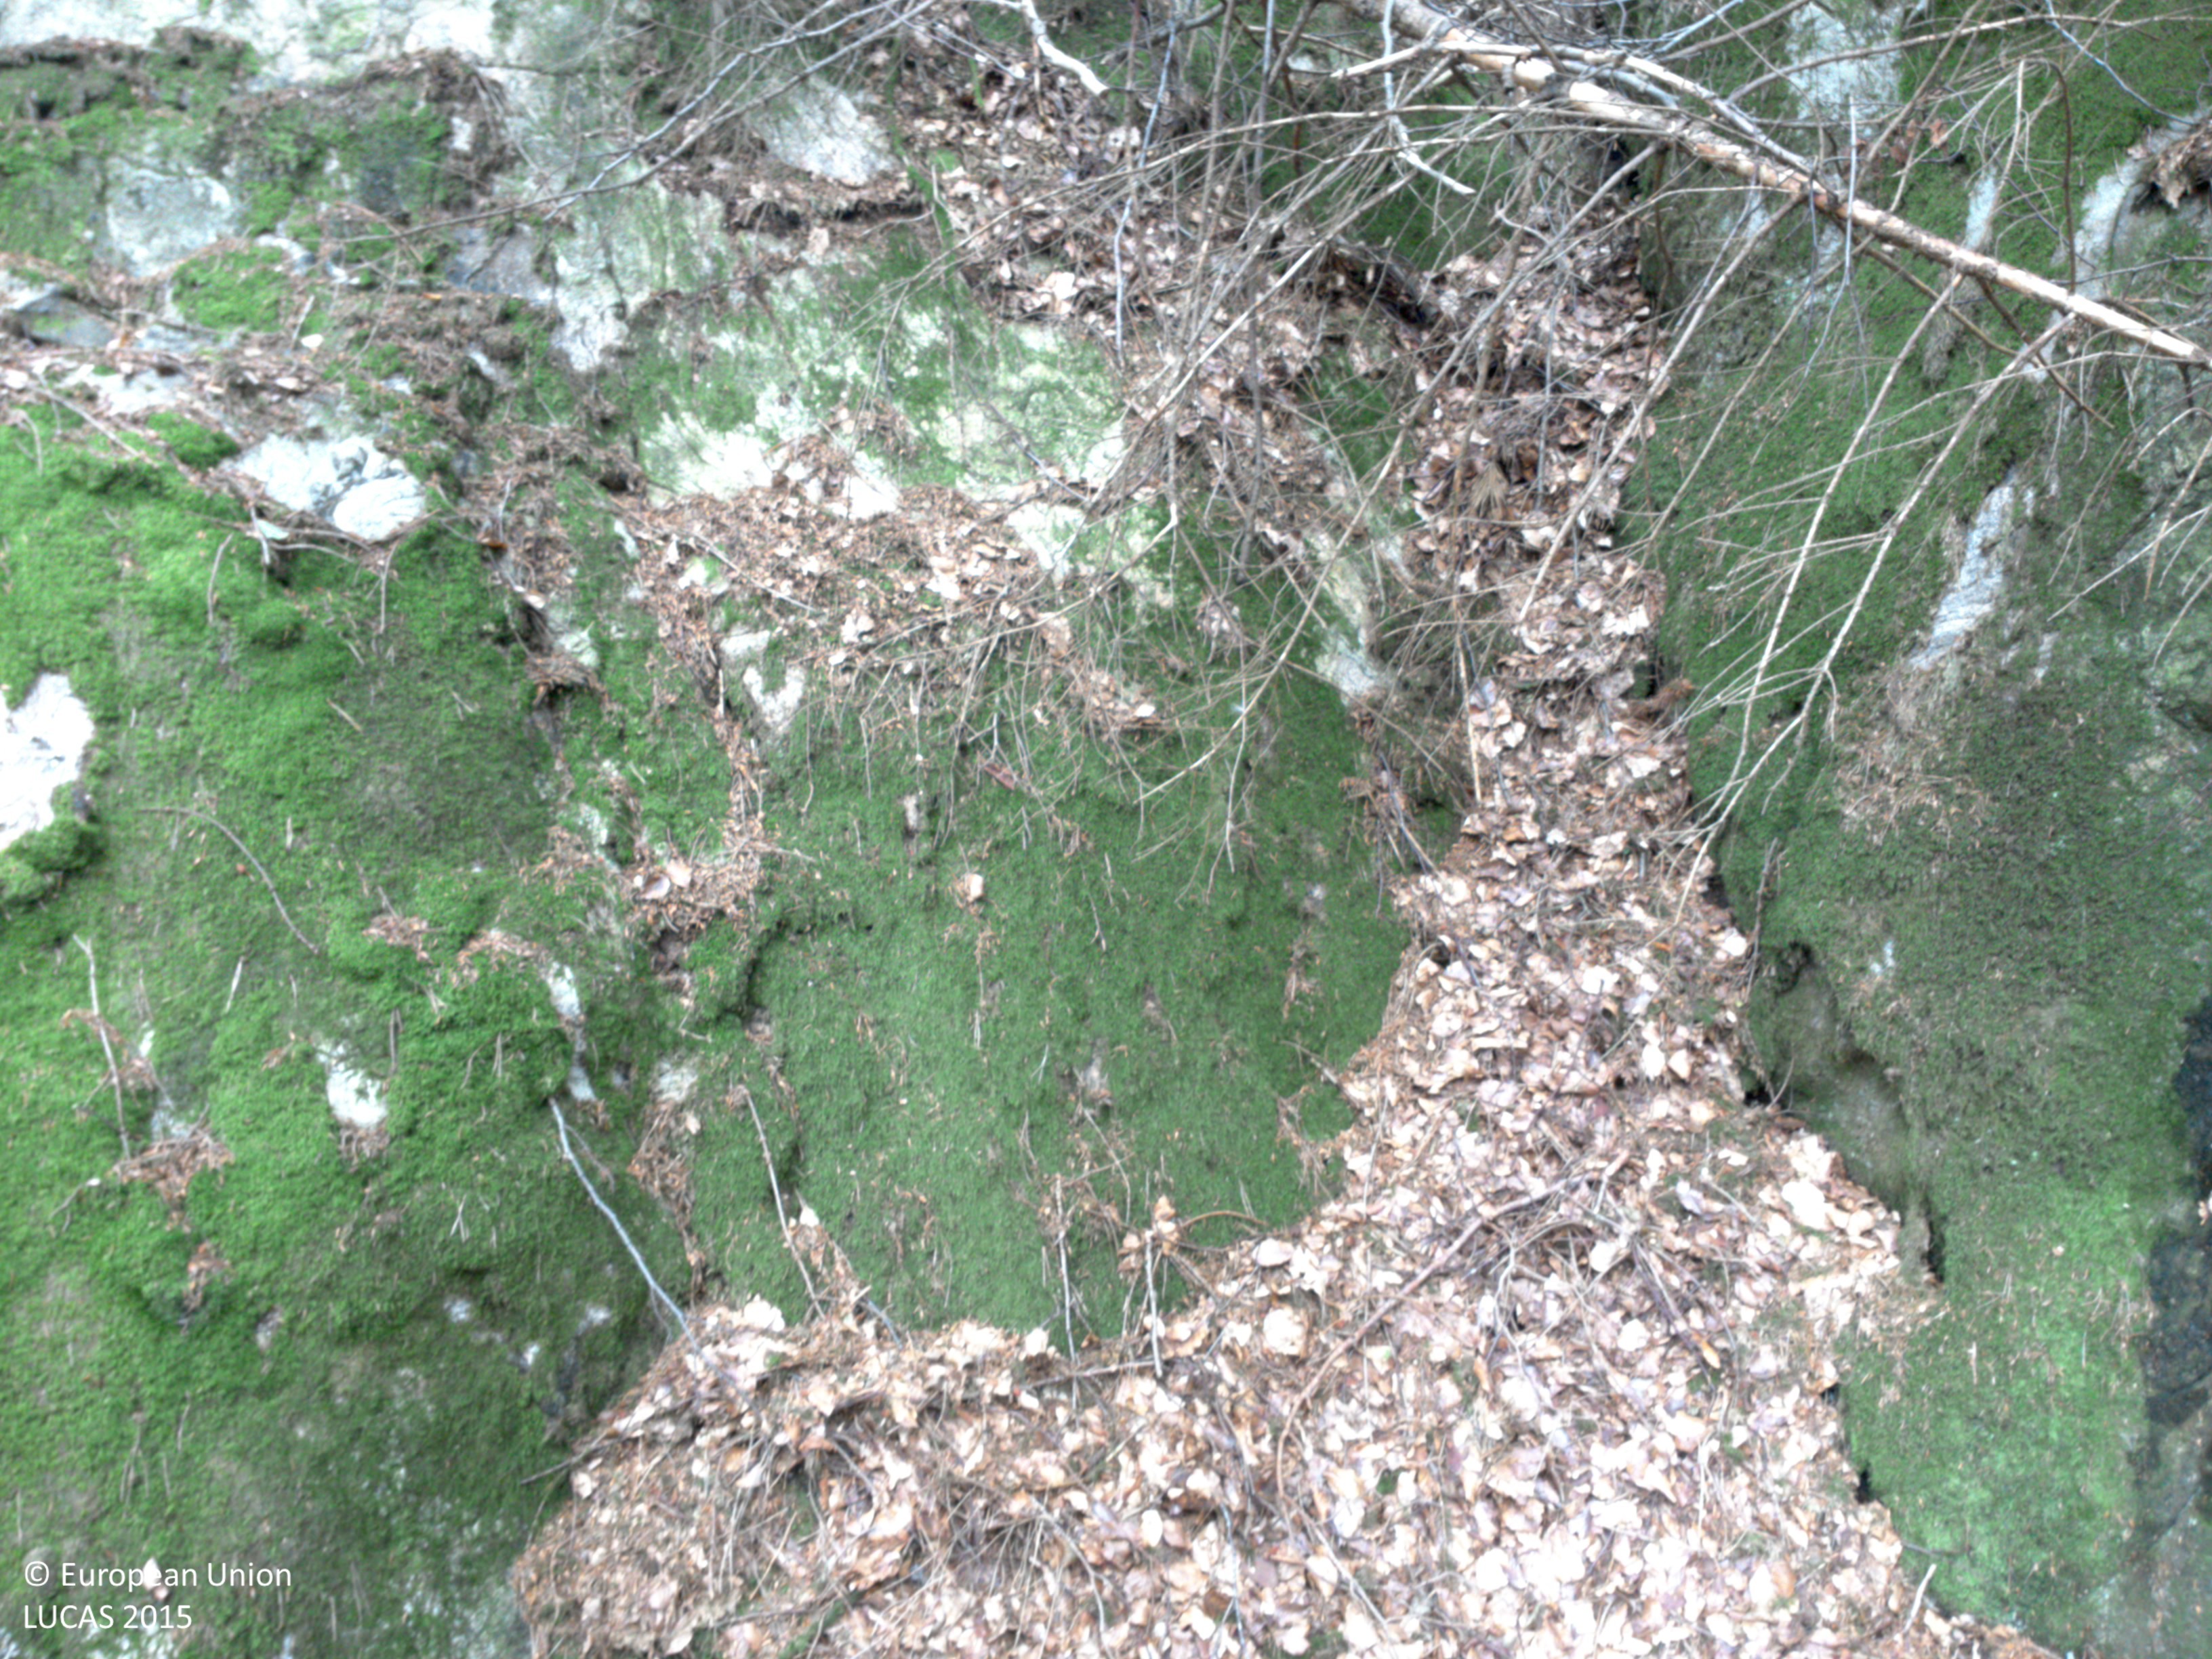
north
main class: Woodland
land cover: Spruce dominated mixed woodland
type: boreal forest
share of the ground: 50 - 75 %
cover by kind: unconsolidated bare surface 40 %, broadleaved forest trees 35 %, coniferous forest trees 20 %, shrubs 5 %
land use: Forestry
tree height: > 5 m
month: August
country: SE
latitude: 57.8652
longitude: 11.8340
